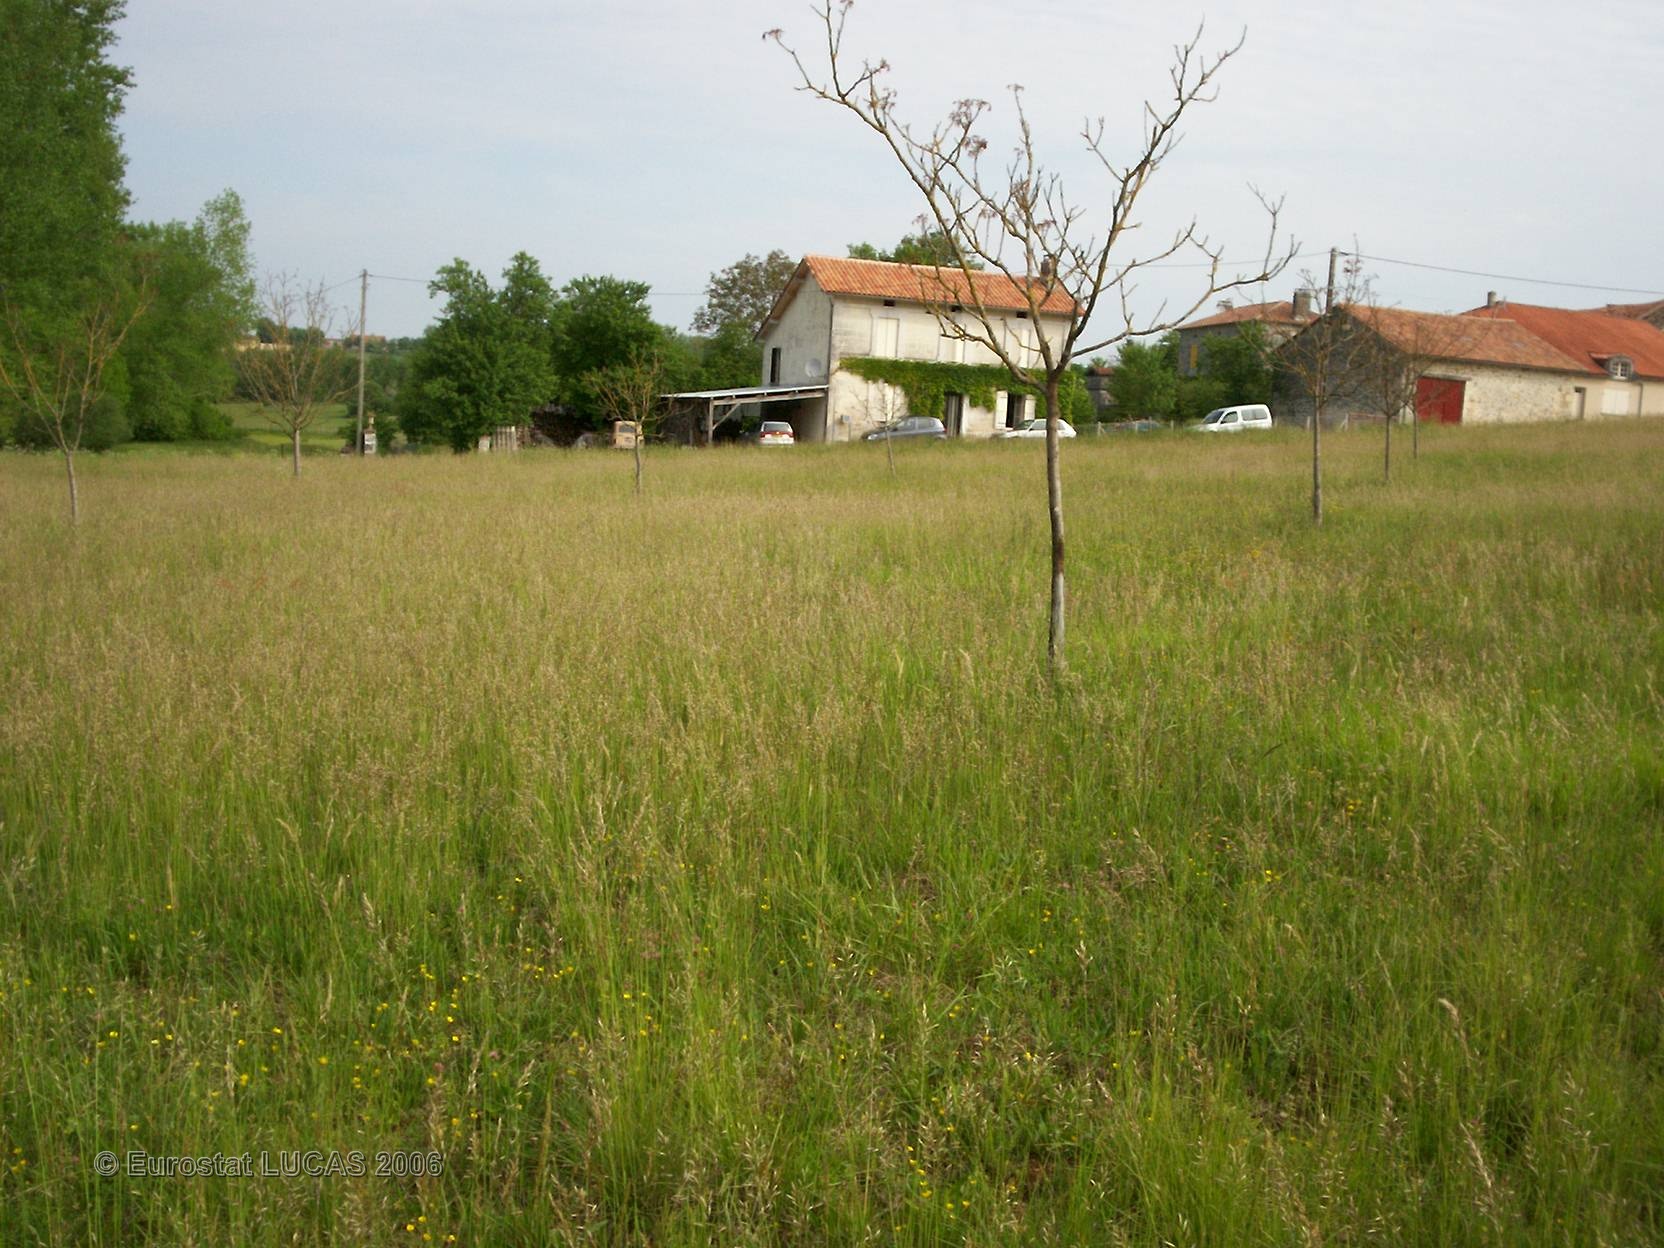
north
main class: Grassland
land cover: Grassland with sparse tree/shrub cover
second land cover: Nuts trees
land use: Agriculture (excluding fallow land and kitchen gardens)
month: May
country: FR
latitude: 45.4951
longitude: 0.5306
